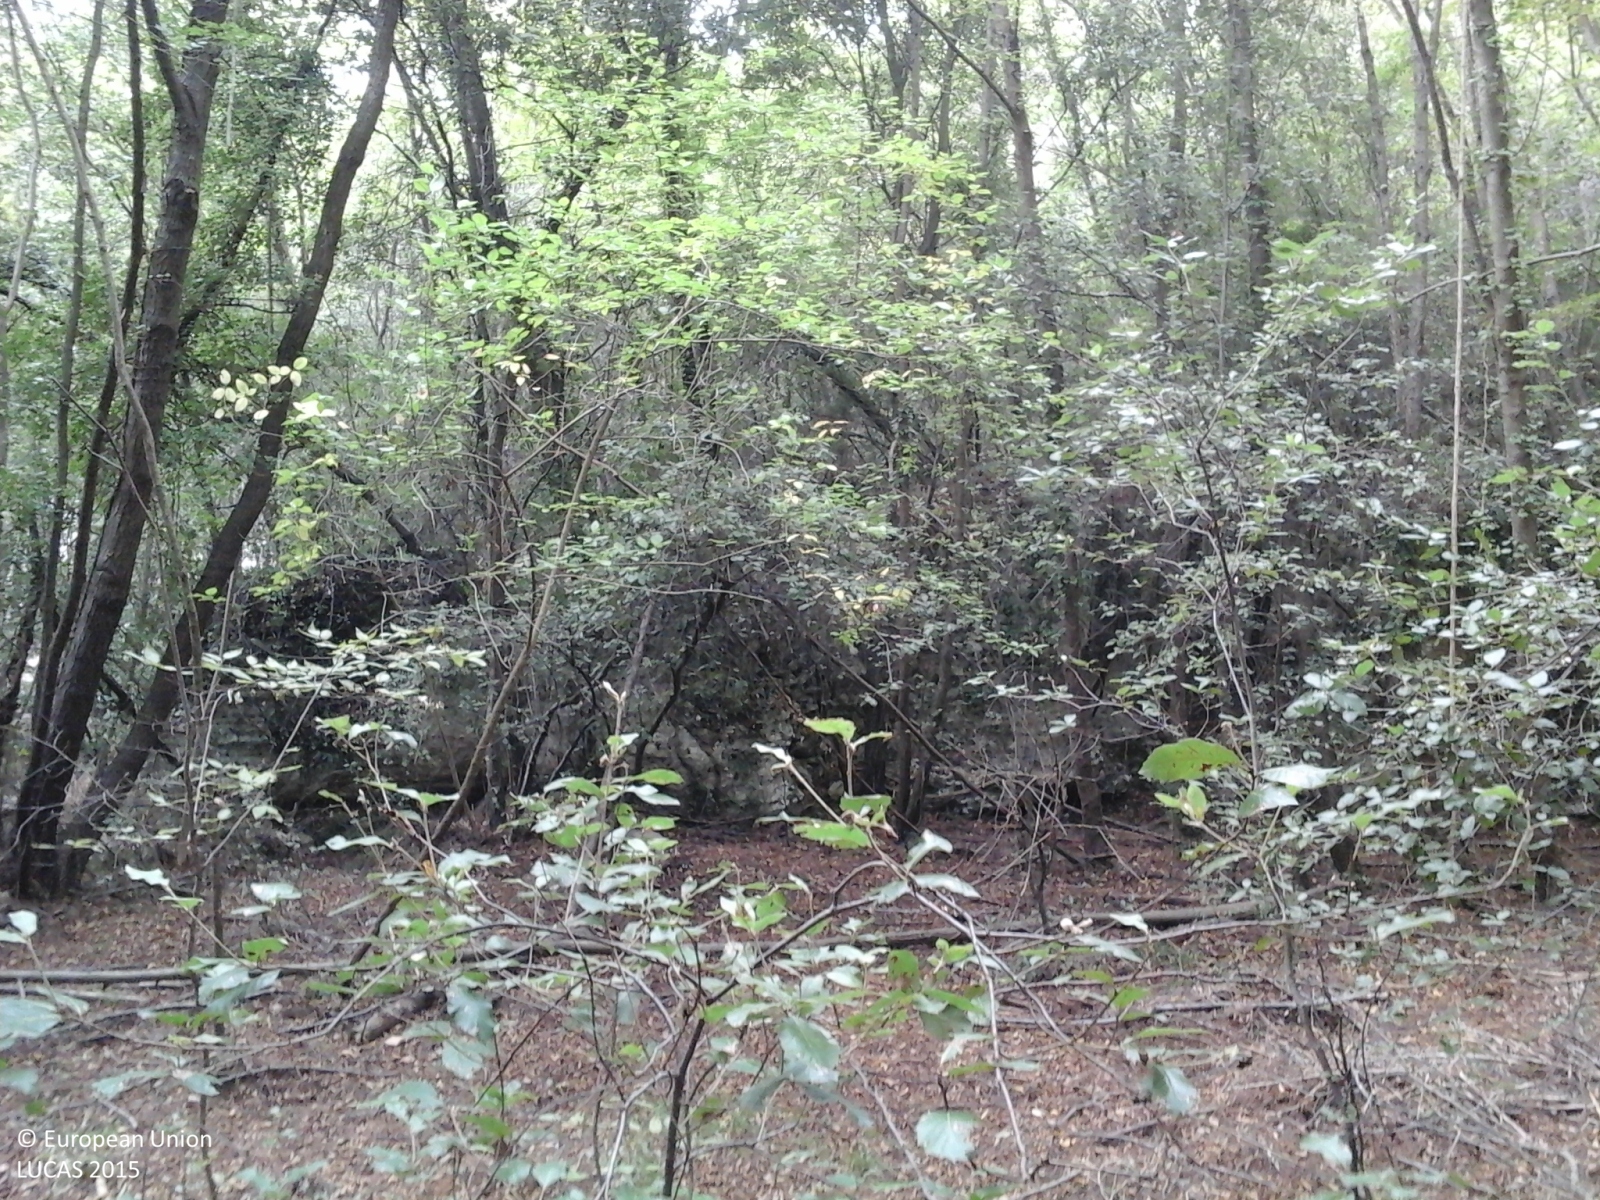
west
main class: Woodland
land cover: Broadleaved woodland
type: thermophilous deciduous forest
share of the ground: > 75 %
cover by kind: broadleaved forest trees 100 %
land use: Semi-natural and natural areas not in use
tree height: > 5 m
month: September
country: IT
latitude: 44.1930
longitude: 8.3398
